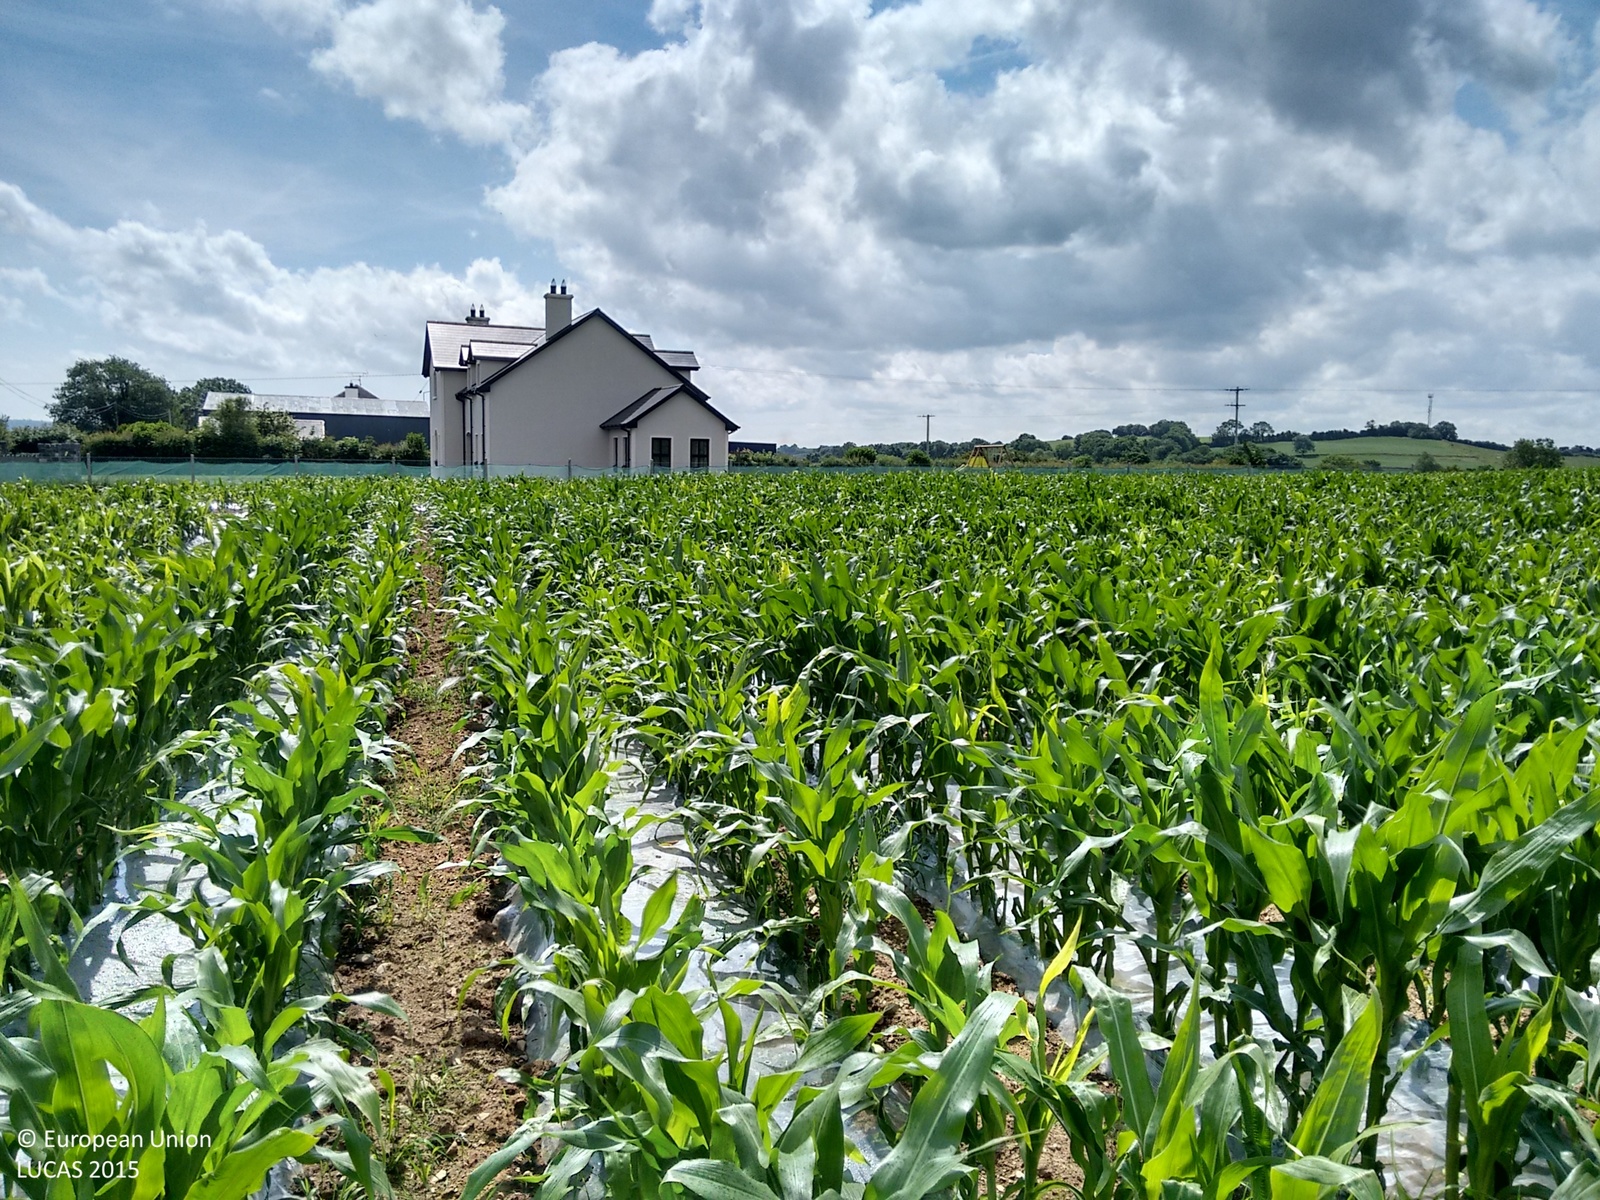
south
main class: Cropland
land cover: Maize
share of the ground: > 75 %
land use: Agriculture (excluding fallow land and kitchen gardens)
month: July
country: IE
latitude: 53.8073
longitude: -6.7308
